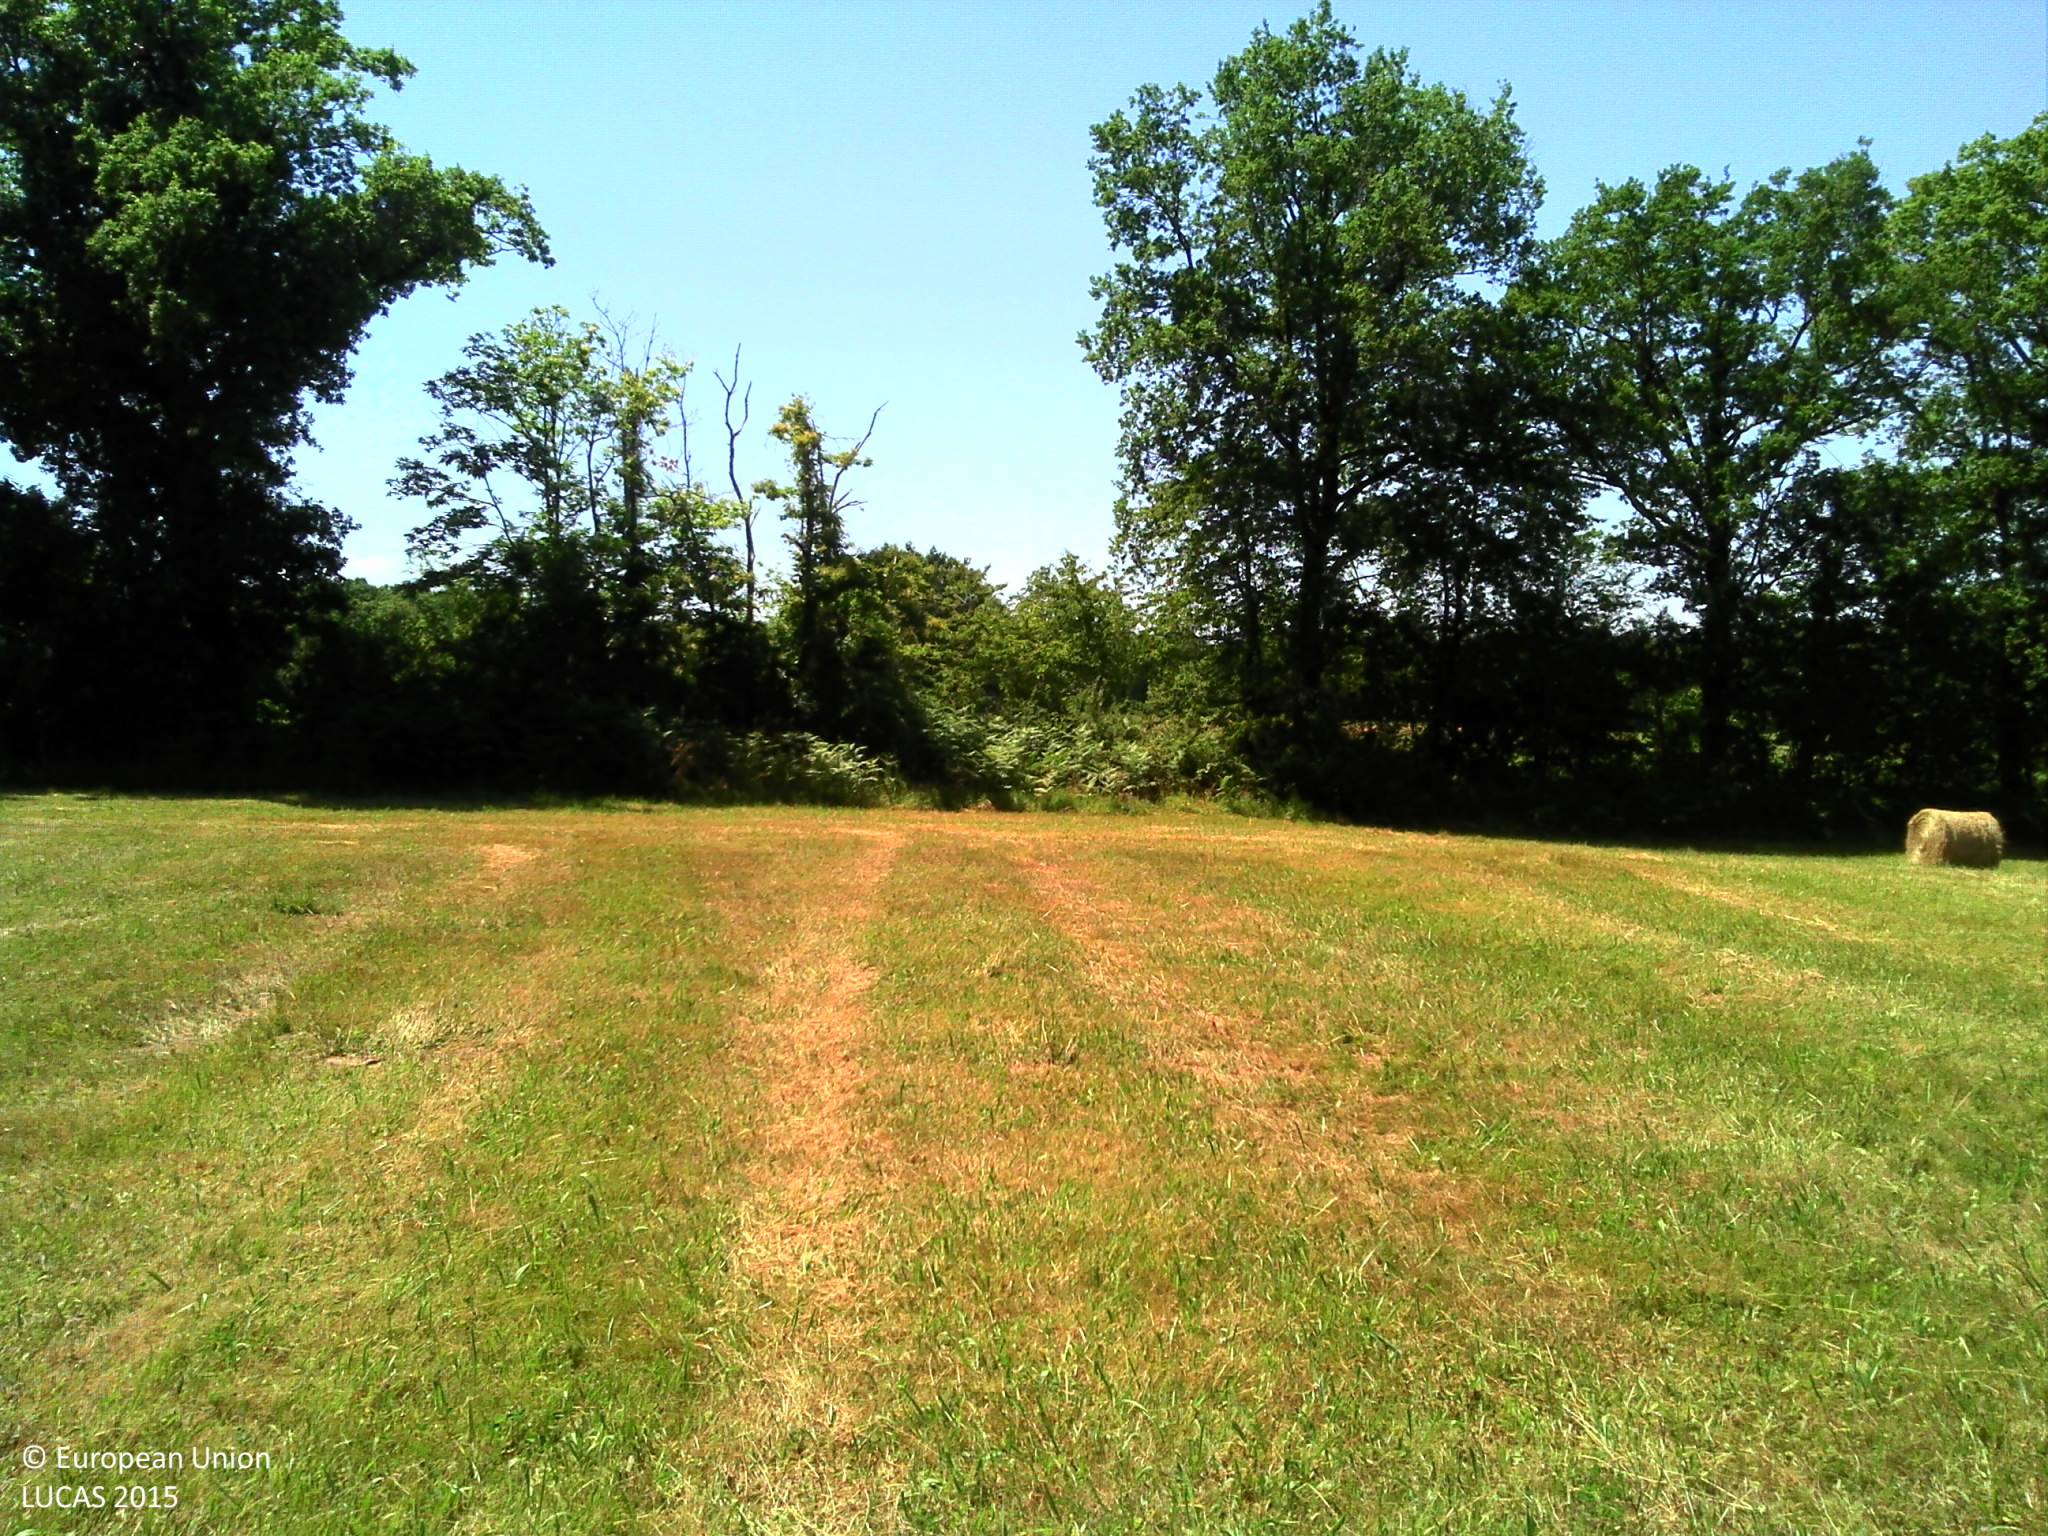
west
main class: Grassland
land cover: Grassland without tree/shrub cover
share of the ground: > 75 %
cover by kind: herbaceous plants 100 %
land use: Agriculture (excluding fallow land and kitchen gardens)
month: June
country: FR
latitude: 45.7811
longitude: 0.6880
